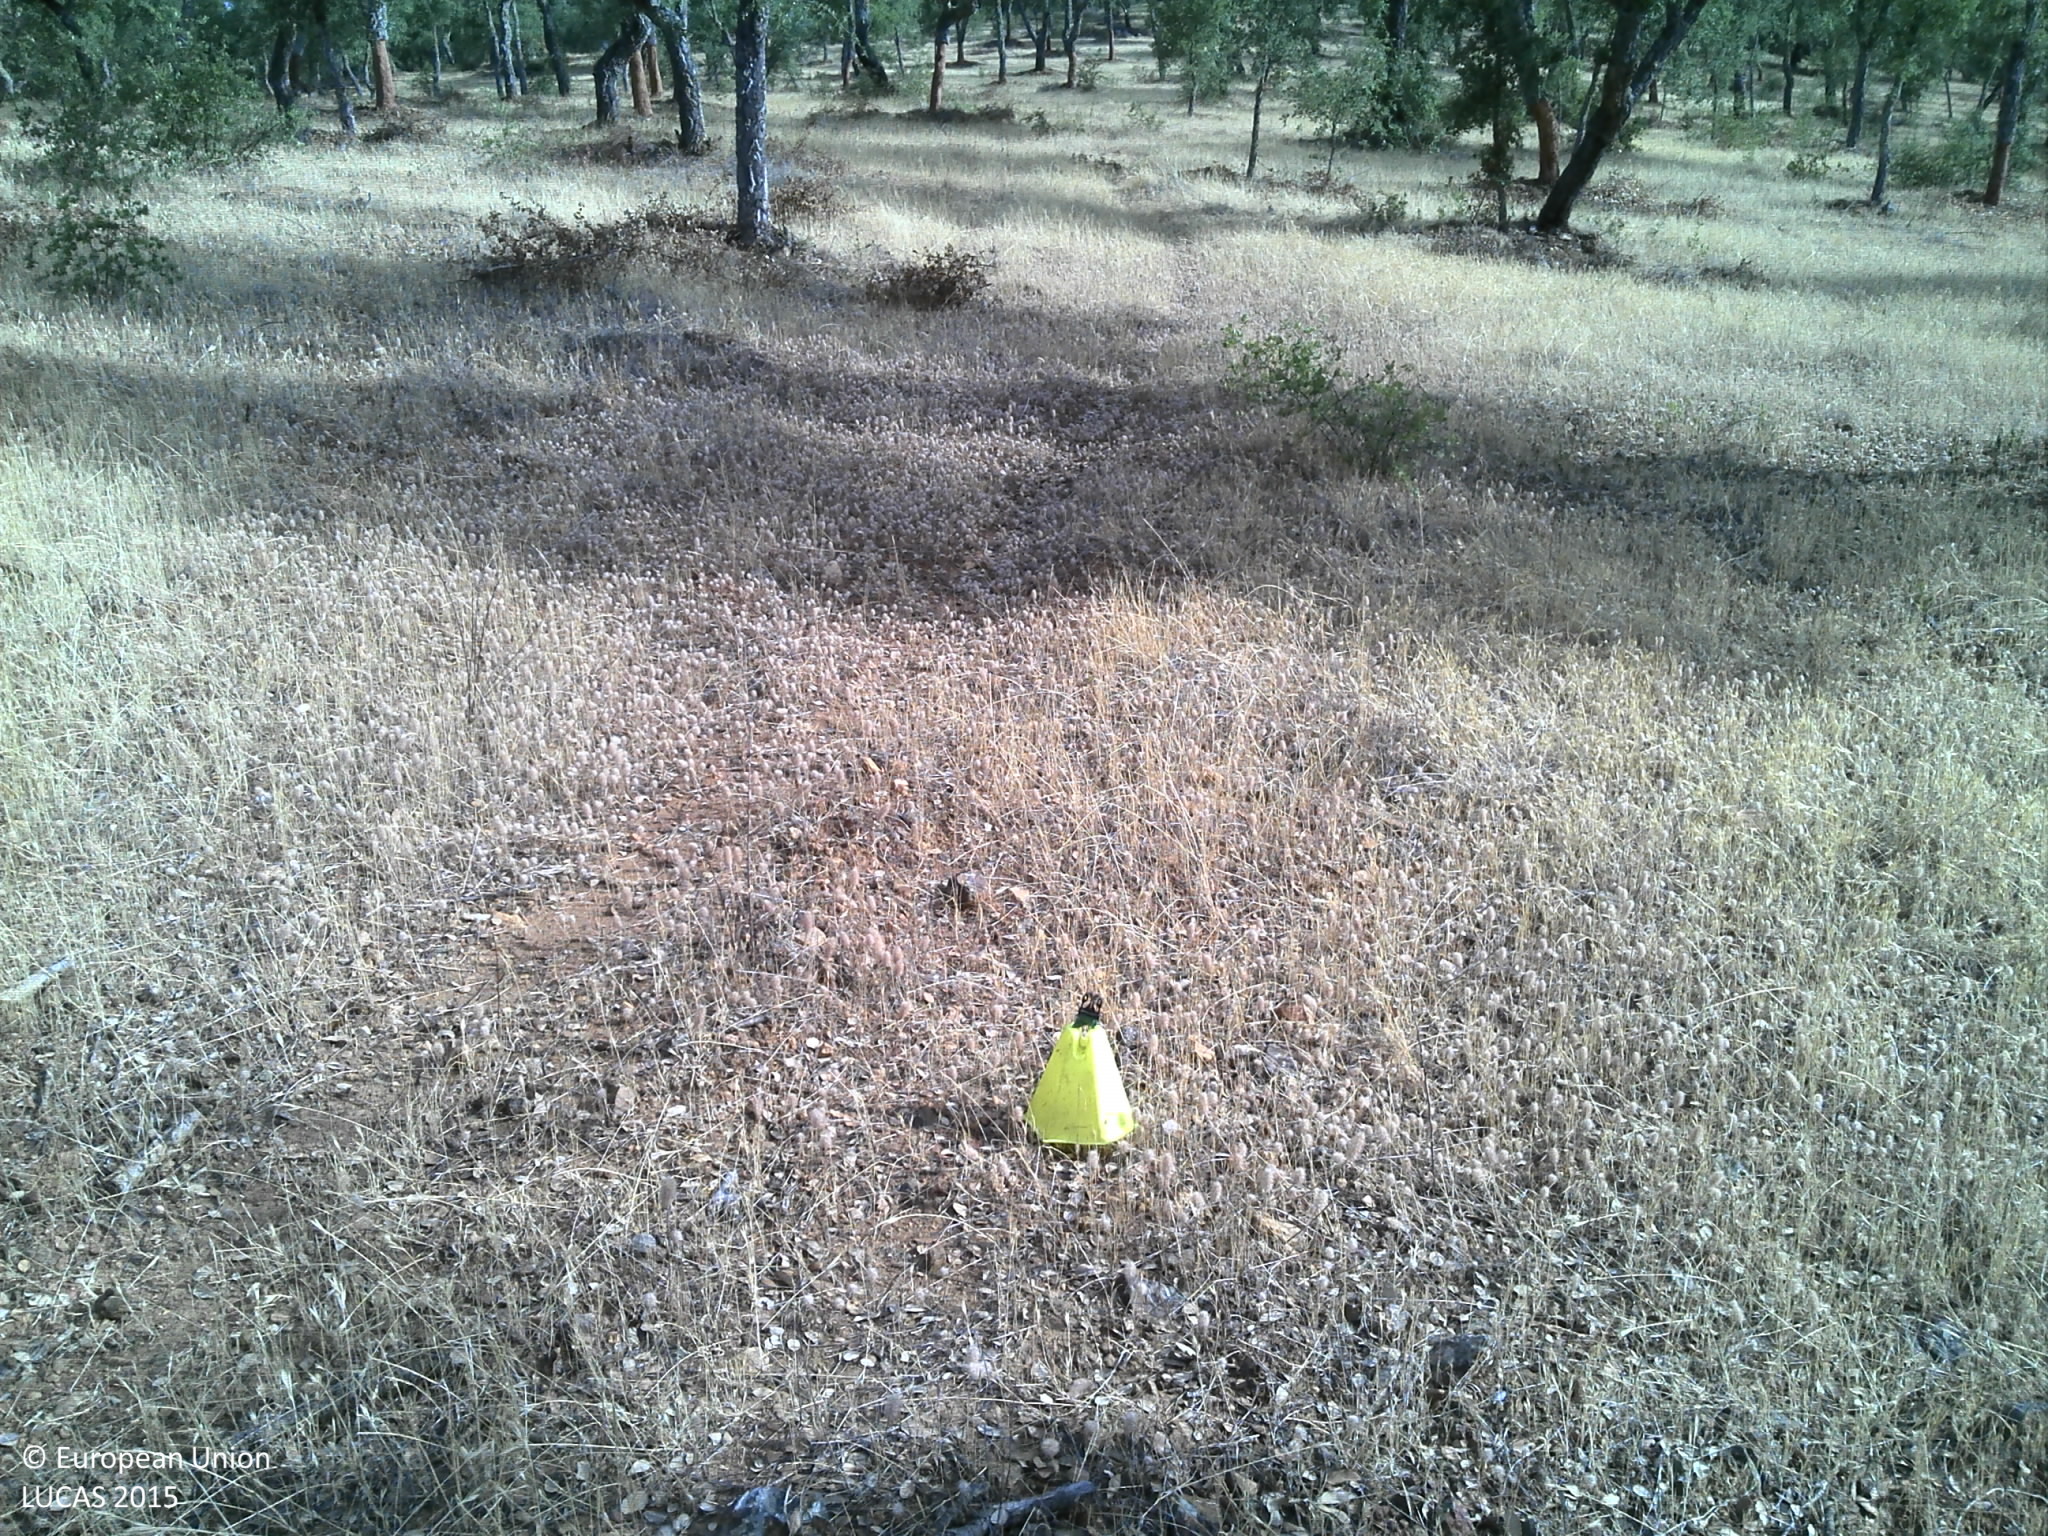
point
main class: Woodland
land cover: Broadleaved woodland
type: broadleaved evergreen forest
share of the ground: 25 - 50 %
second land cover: Grassland without tree/shrub cover
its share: 50 - 75 %
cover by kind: herbaceous plants 55 %, broadleaved forest trees 30 %, unconsolidated bare surface 10 %, shrubs 5 %
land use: Forestry
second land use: Agriculture (excluding fallow land and kitchen gardens)
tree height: > 5 m
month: July
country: PT
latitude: 38.7591
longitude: -7.7733
